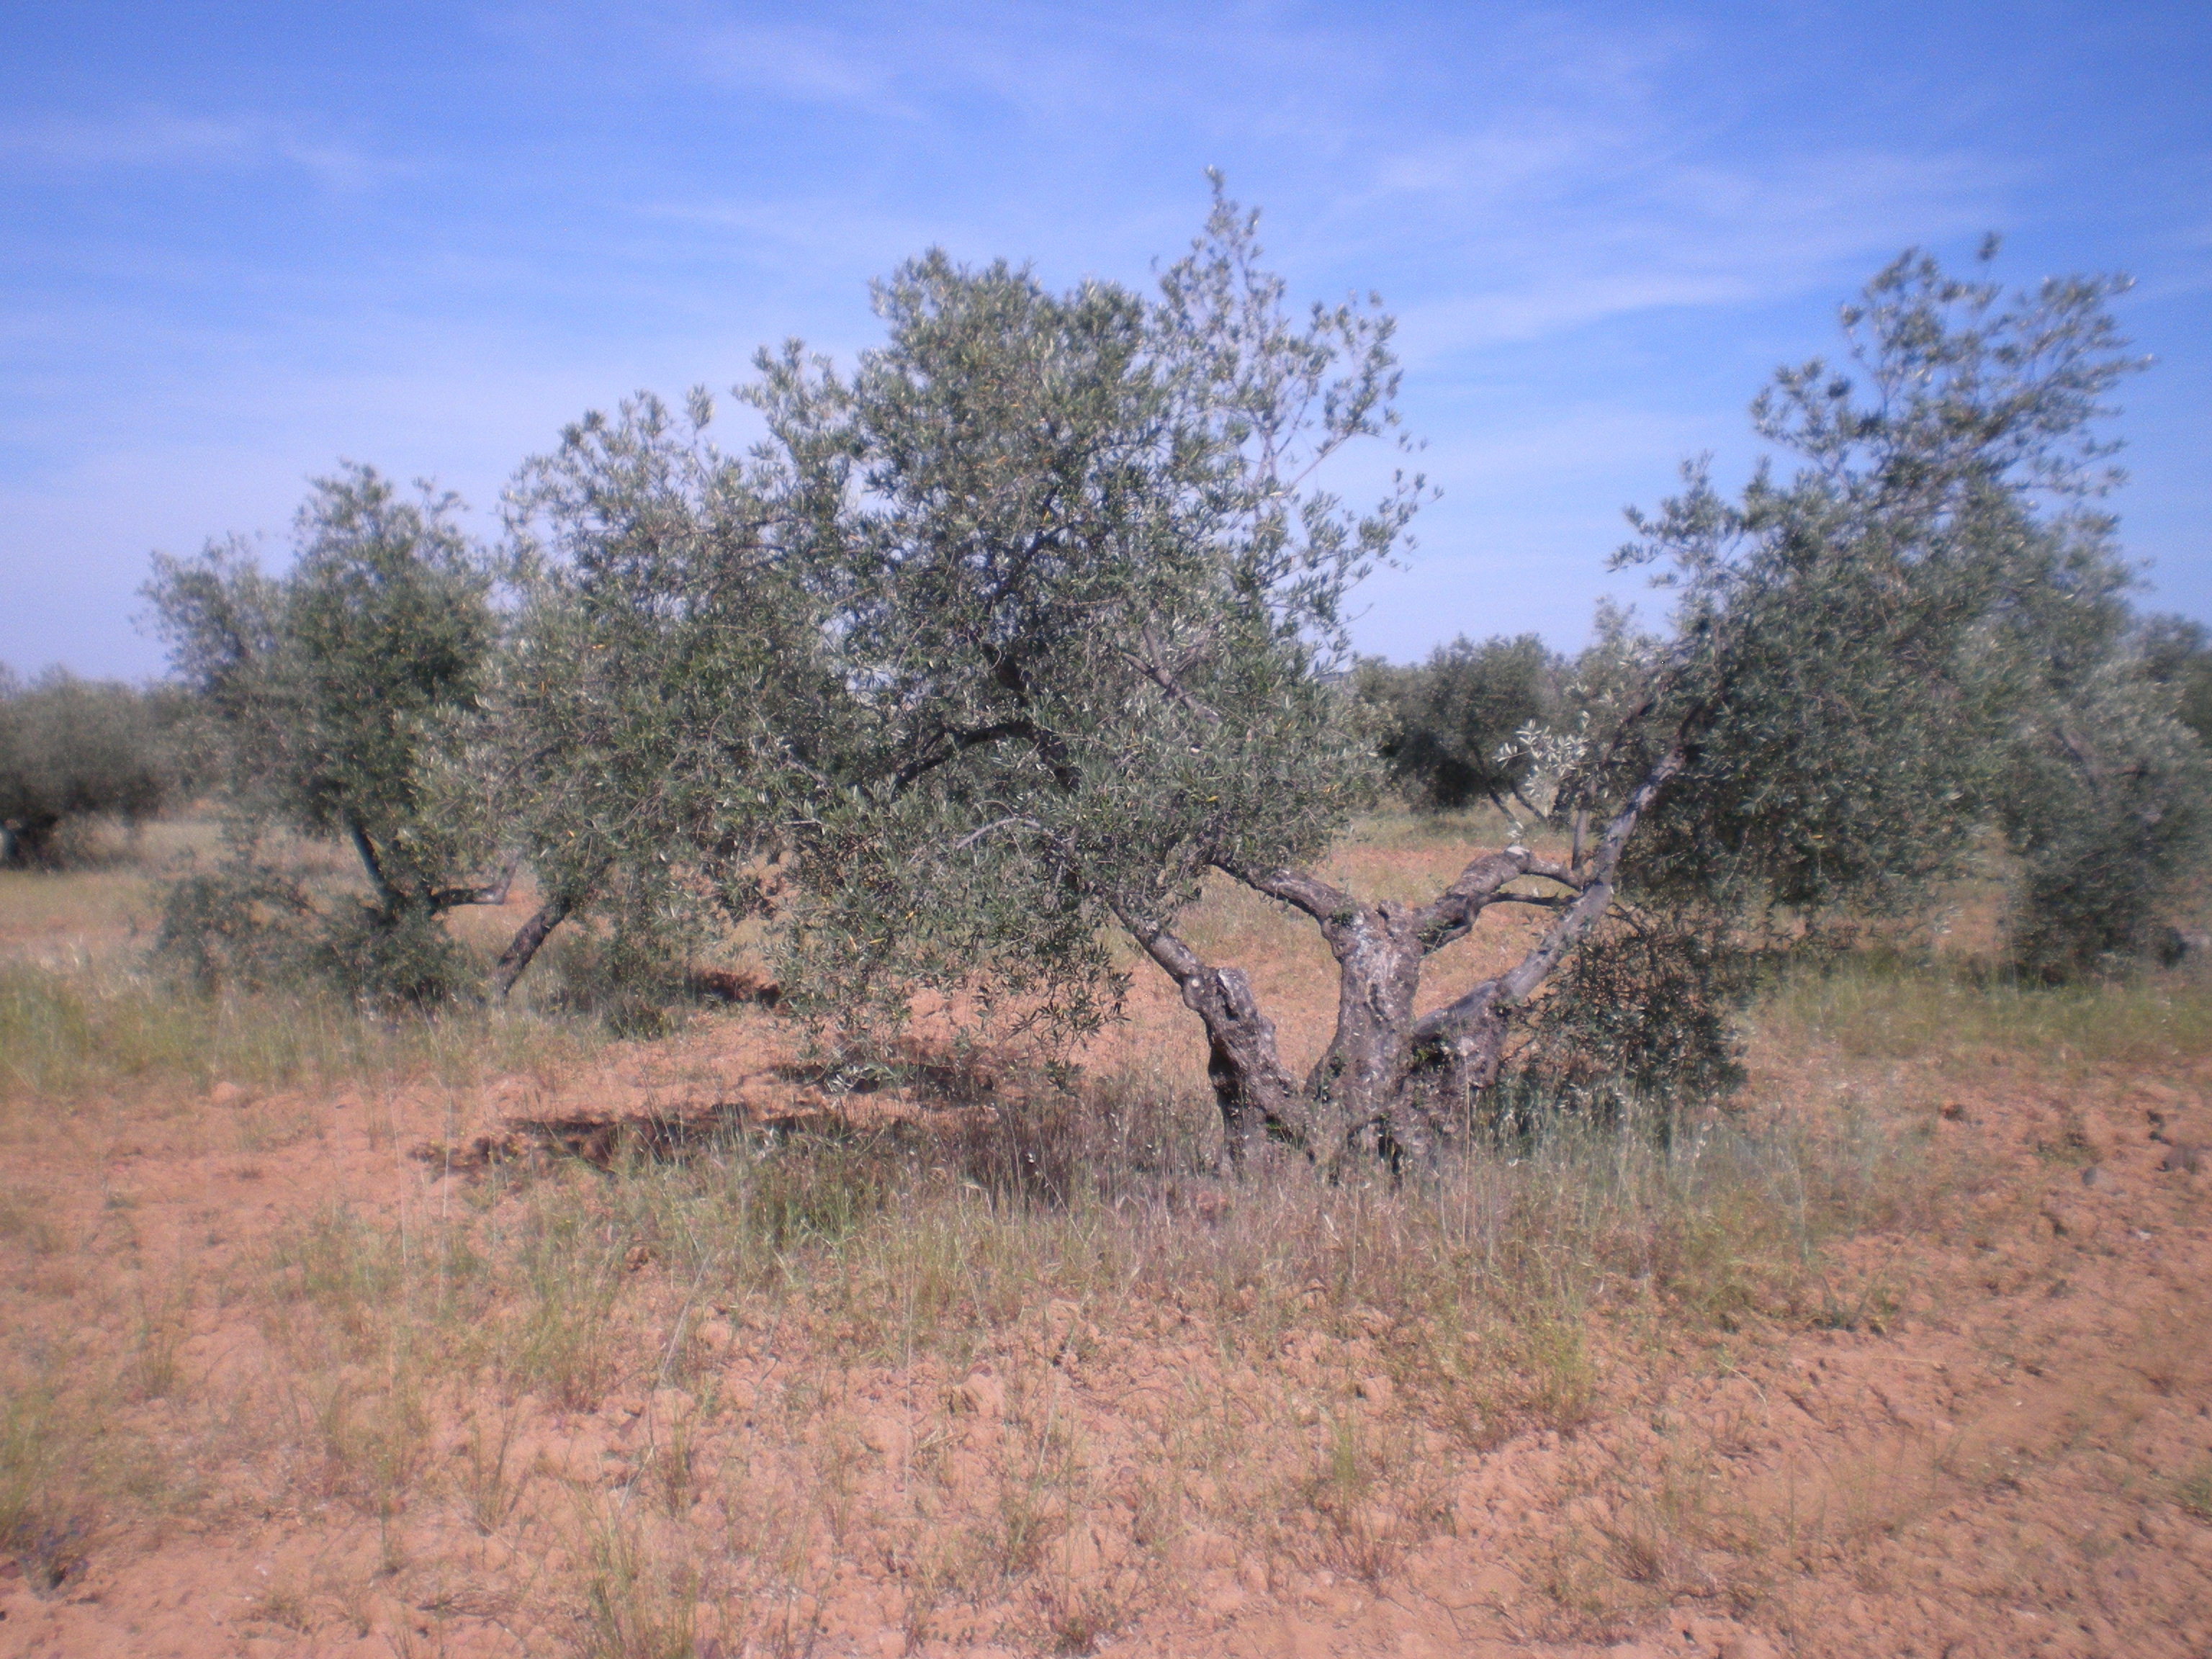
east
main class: Cropland
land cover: Olive groves
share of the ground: 10 - 25 %
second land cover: Spontaneously vegetated surfaces
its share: 10 - 25 %
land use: Agriculture (excluding fallow land and kitchen gardens)
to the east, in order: Olive groves; Spontaneously vegetated surfaces; Grass margins; Tracks; Grass margins; Olive groves; Grass margins; Barley; Olive groves
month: May
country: ES
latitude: 38.5009
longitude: -3.5278
